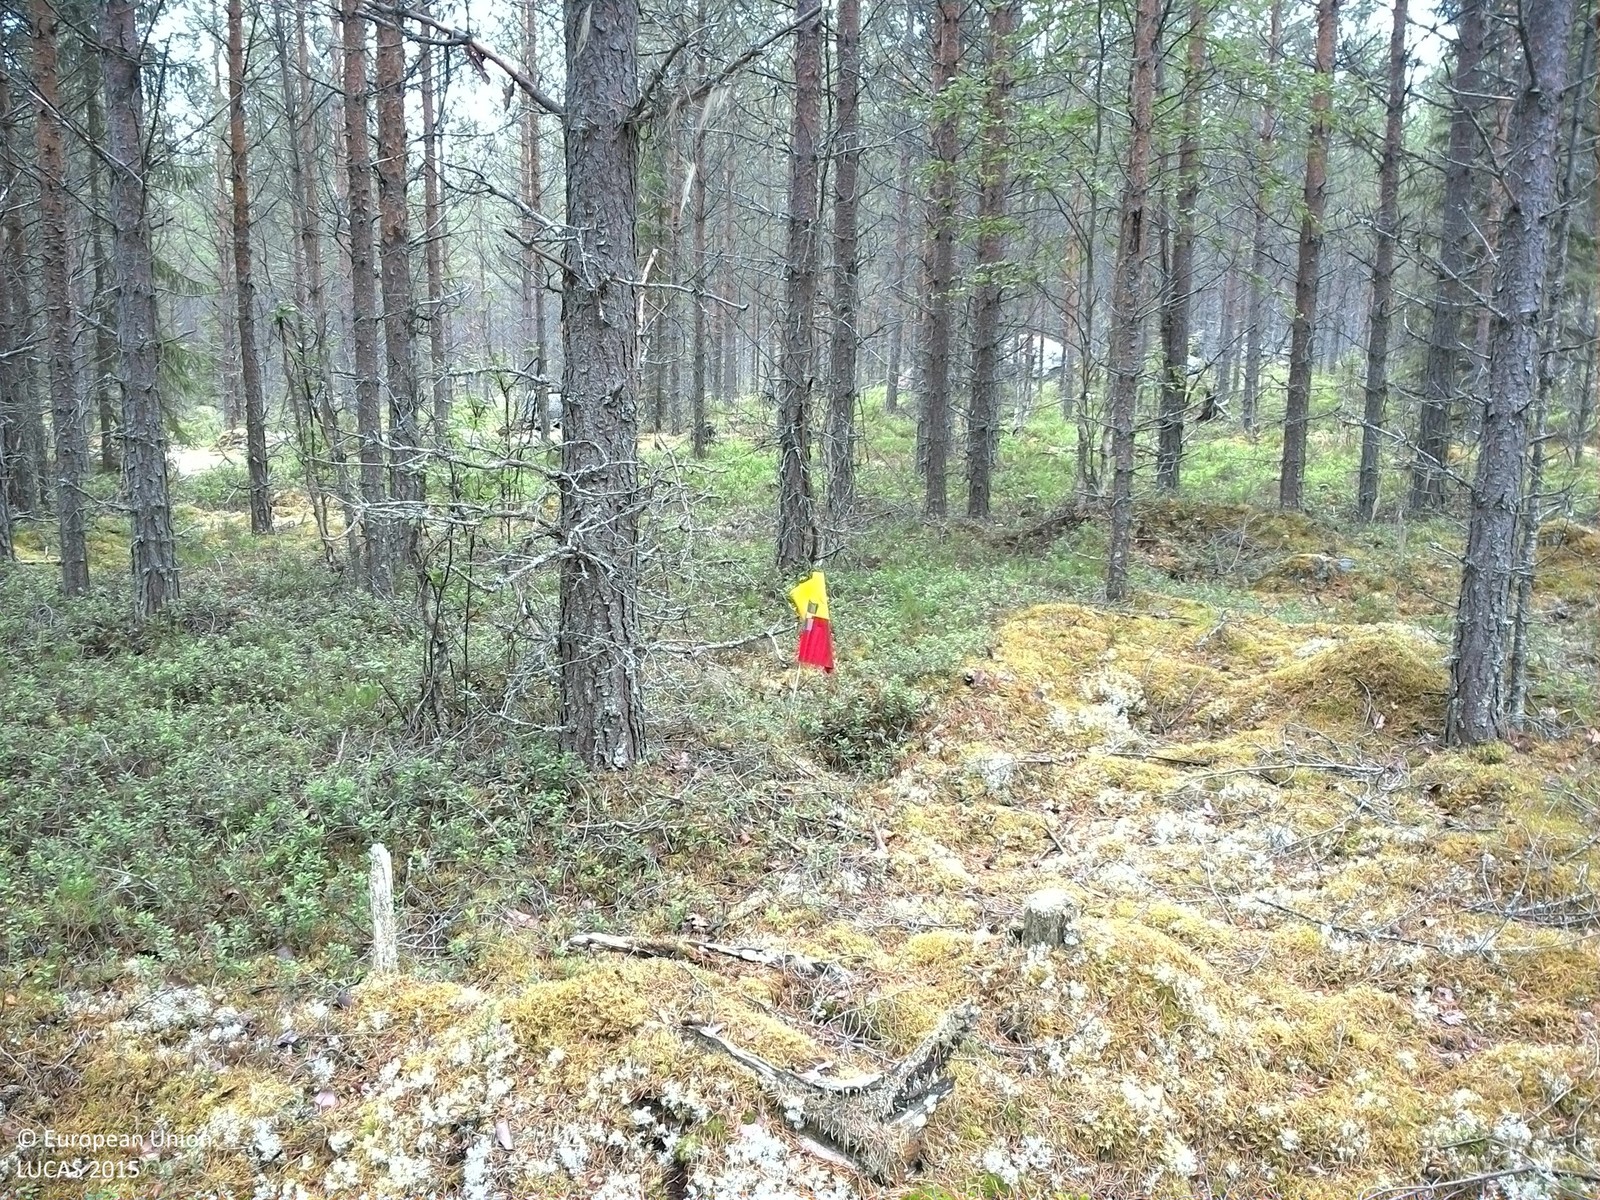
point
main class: Woodland
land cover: Pine dominated coniferous woodland
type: boreal forest
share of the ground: 50 - 75 %
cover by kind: coniferous forest trees 50 %, shrubs 30 %, lichens and mosses 15 %, broadleaved forest trees 5 %
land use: Forestry
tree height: > 5 m
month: July
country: SE
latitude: 63.6050
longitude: 17.0902
